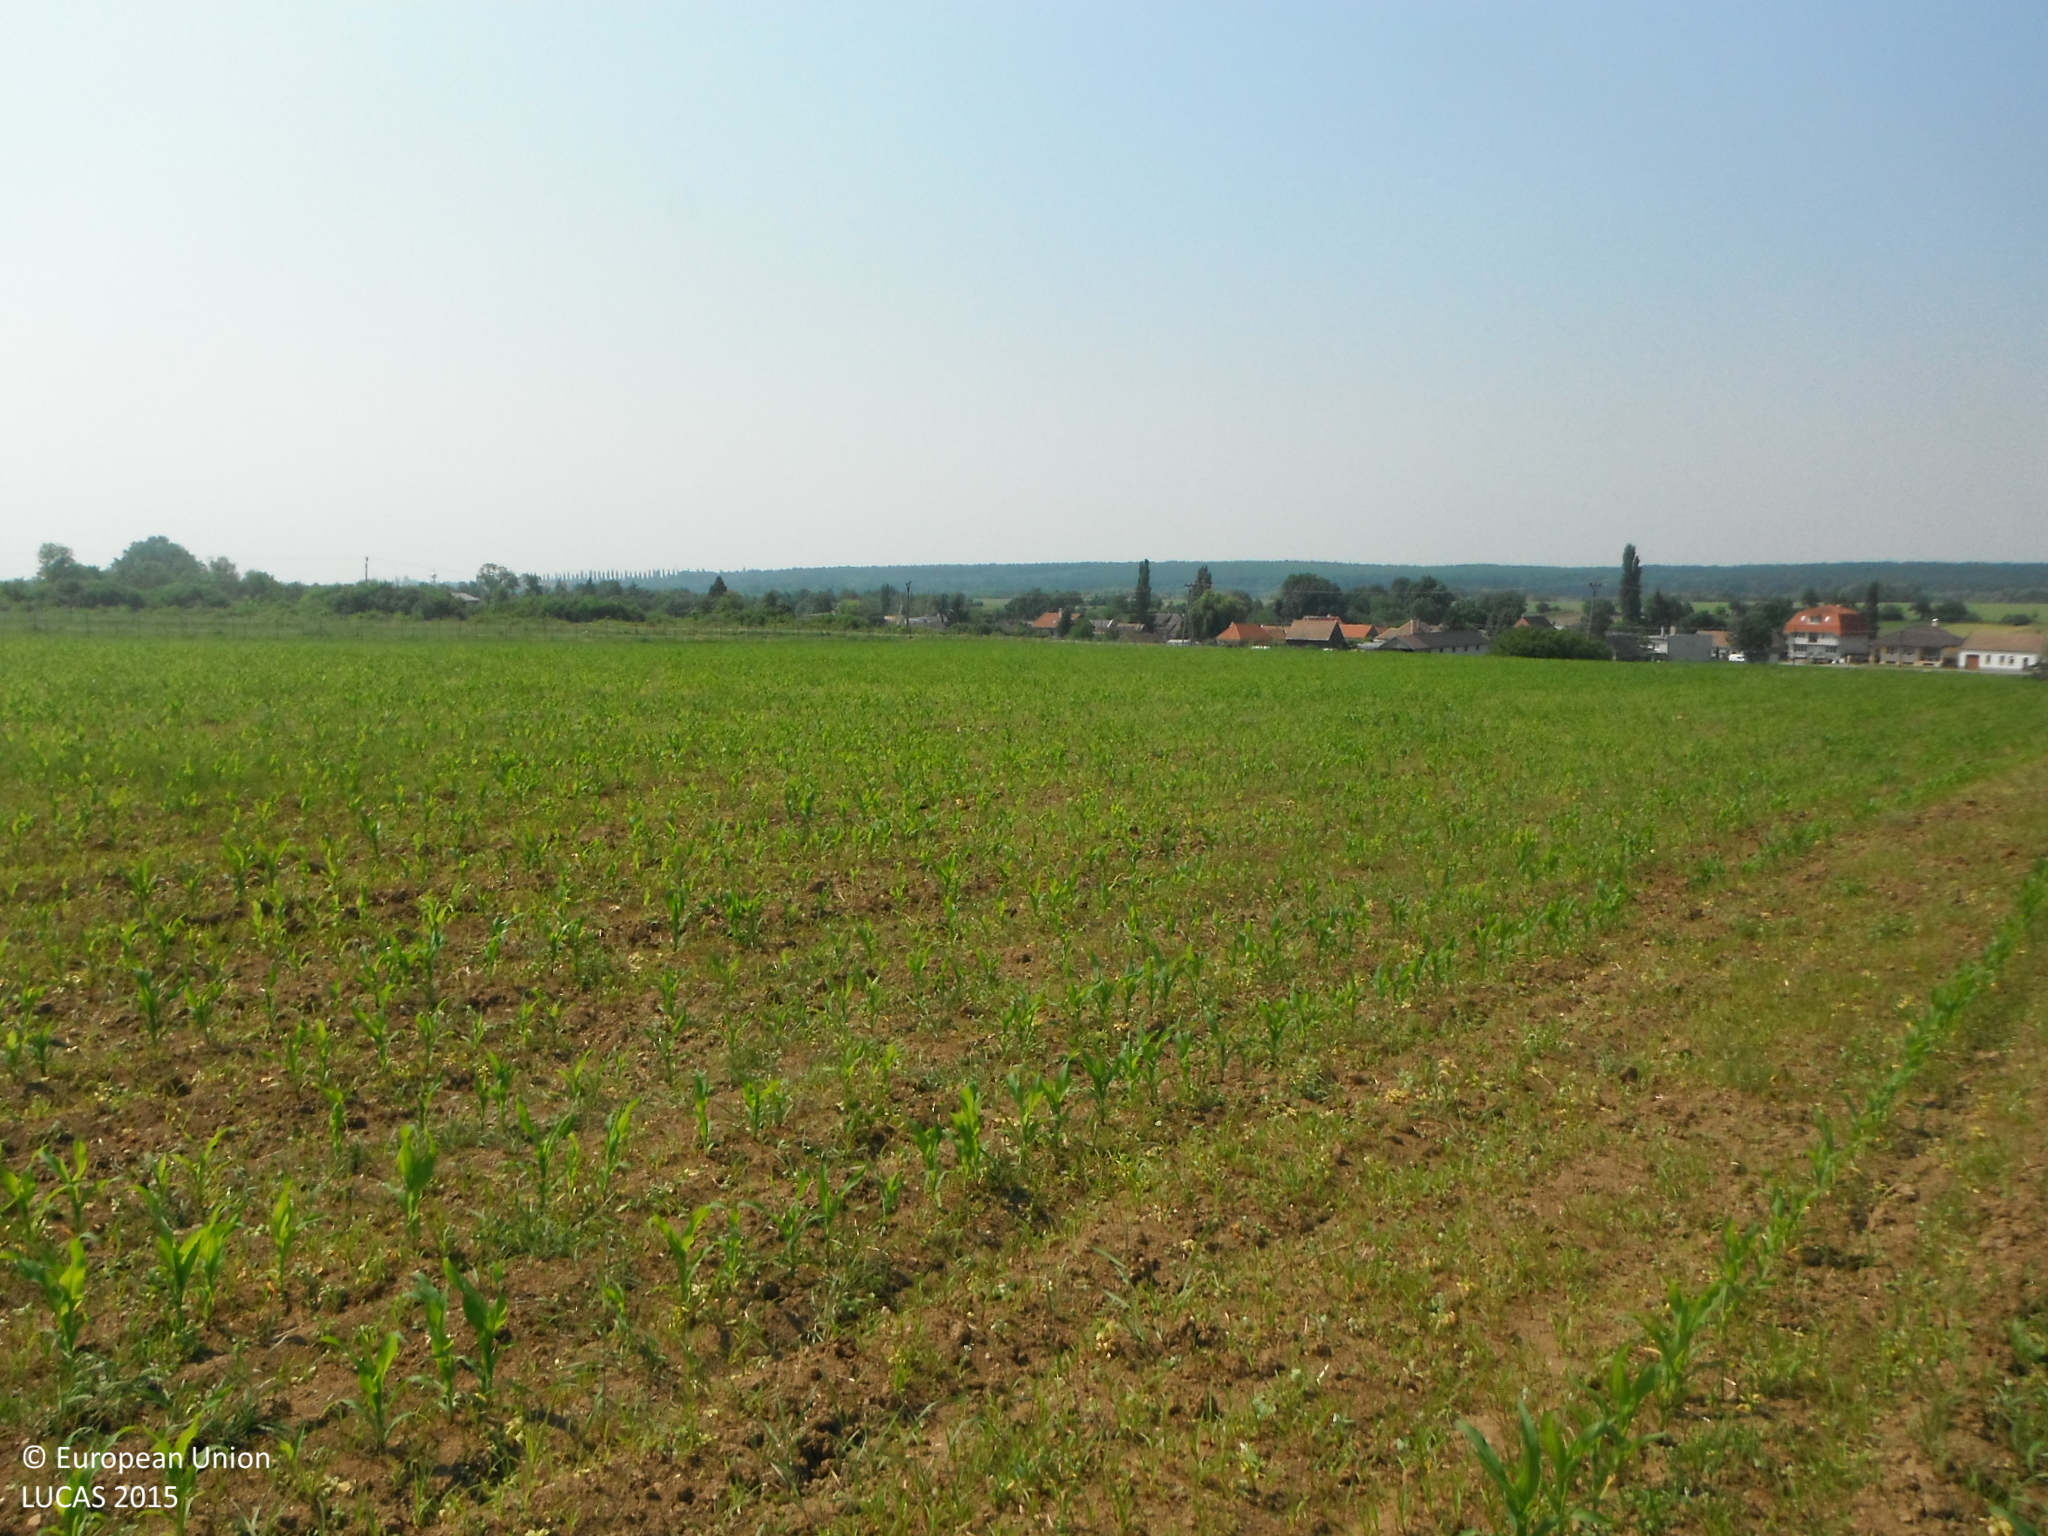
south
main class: Cropland
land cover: Maize
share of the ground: 10 - 25 %
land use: Agriculture (excluding fallow land and kitchen gardens)
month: June
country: SK
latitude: 48.3905
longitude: 17.3969
